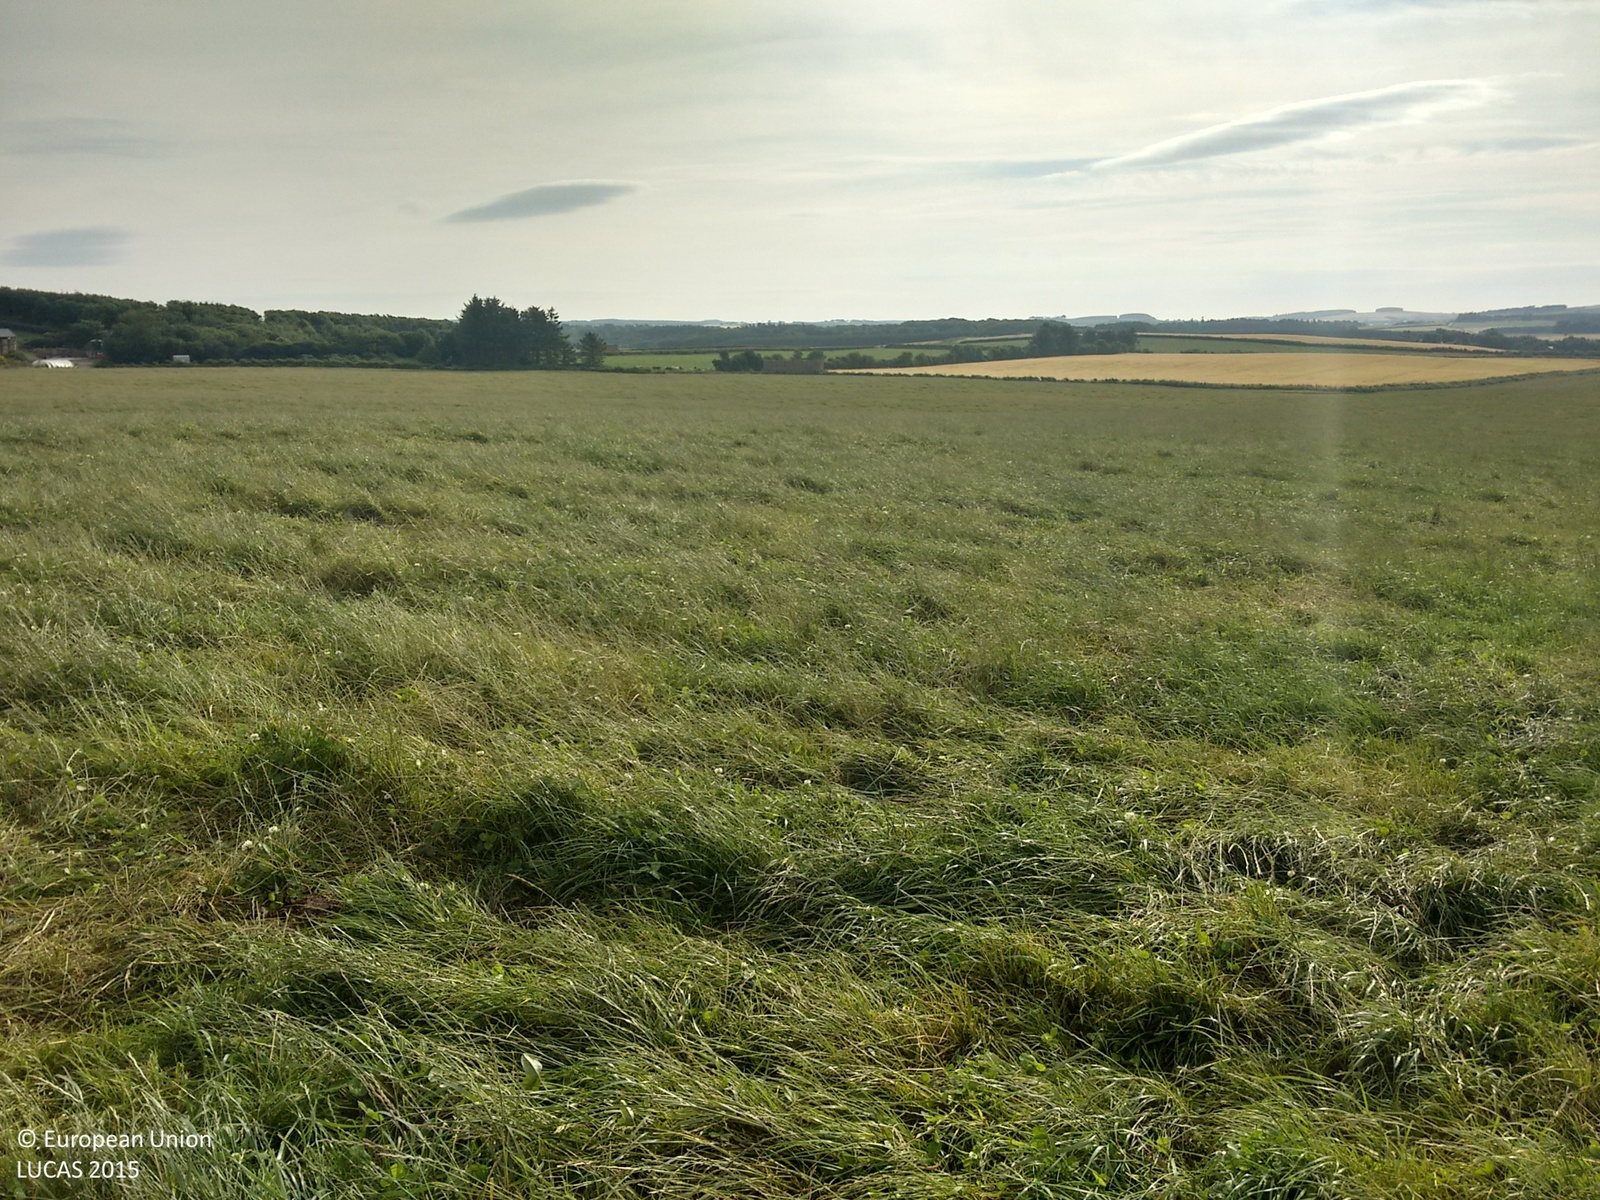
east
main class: Grassland
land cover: Grassland without tree/shrub cover
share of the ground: > 75 %
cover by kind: herbaceous plants 100 %
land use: Agriculture (excluding fallow land and kitchen gardens)
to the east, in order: Grassland without tree/shrub cover; Fences; Abandoned hedges; Fences; Grass margins; Barley
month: August
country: GB
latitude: 57.5345
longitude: -2.1908
